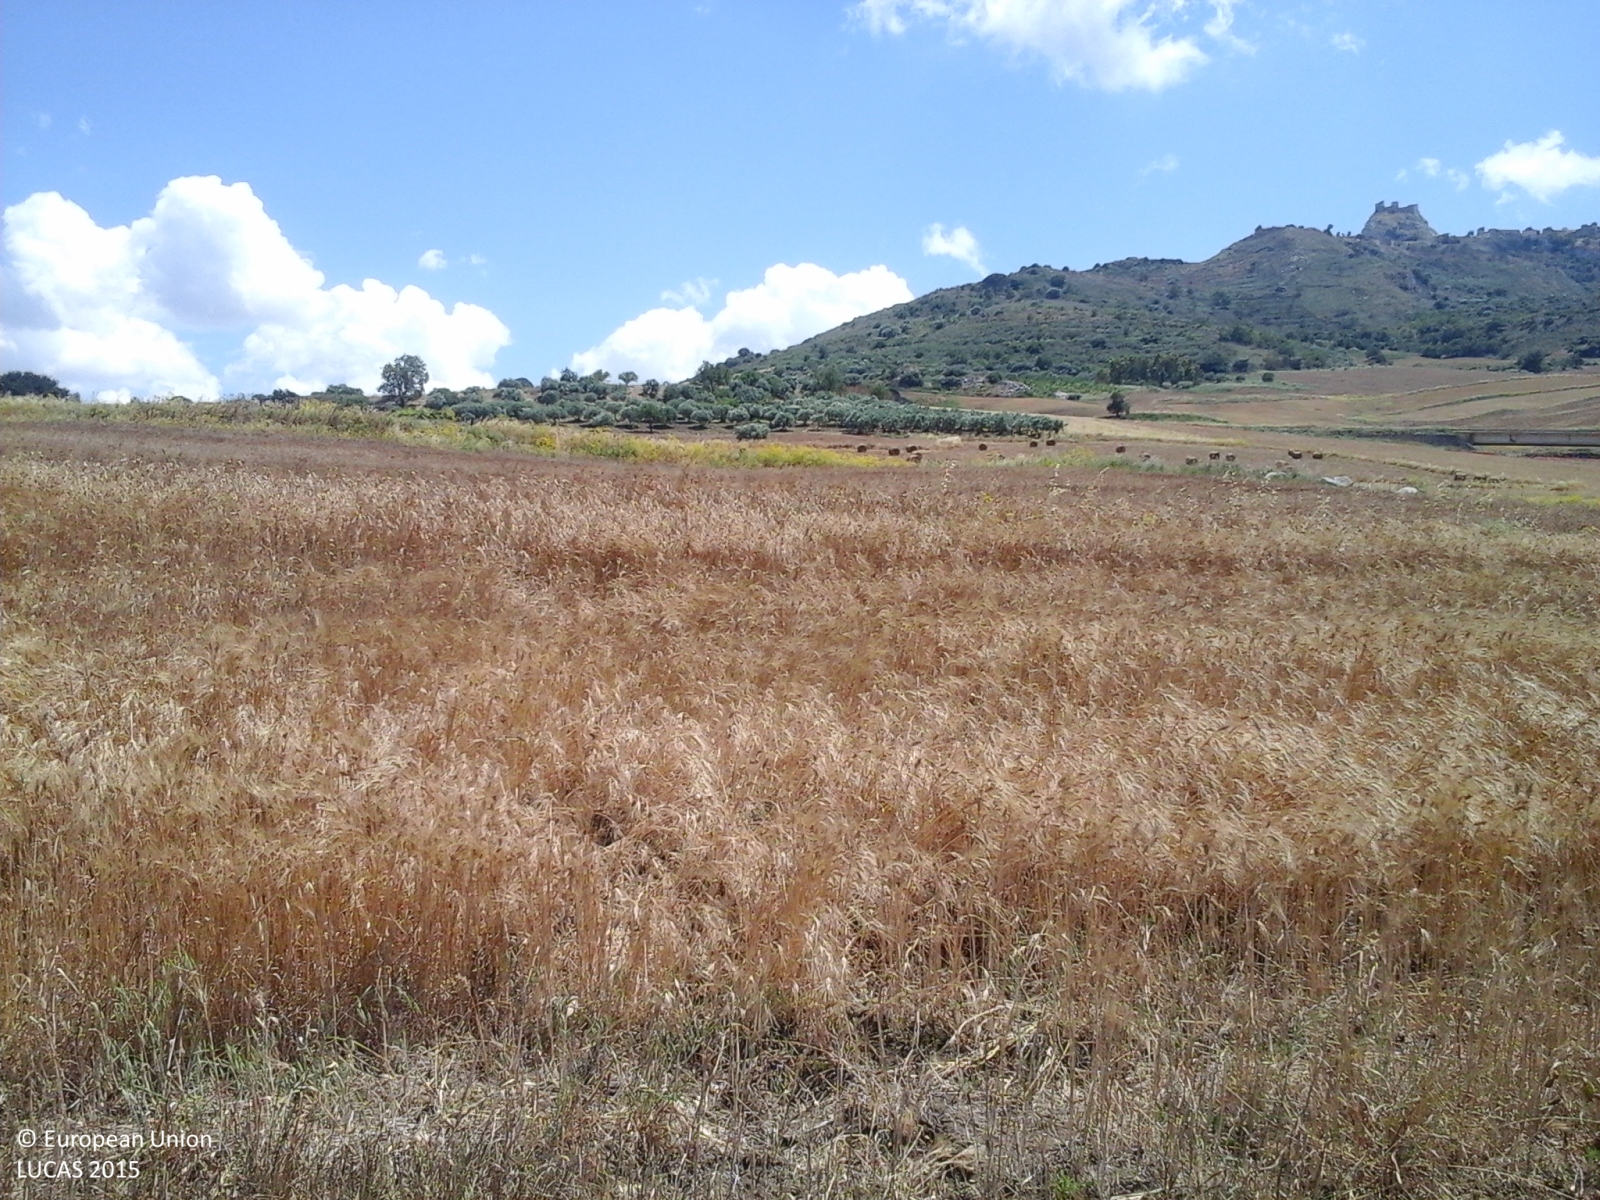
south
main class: Cropland
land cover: Durum wheat
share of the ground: > 75 %
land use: Agriculture (excluding fallow land and kitchen gardens)
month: June
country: IT
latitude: 37.8438
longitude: 13.5765
